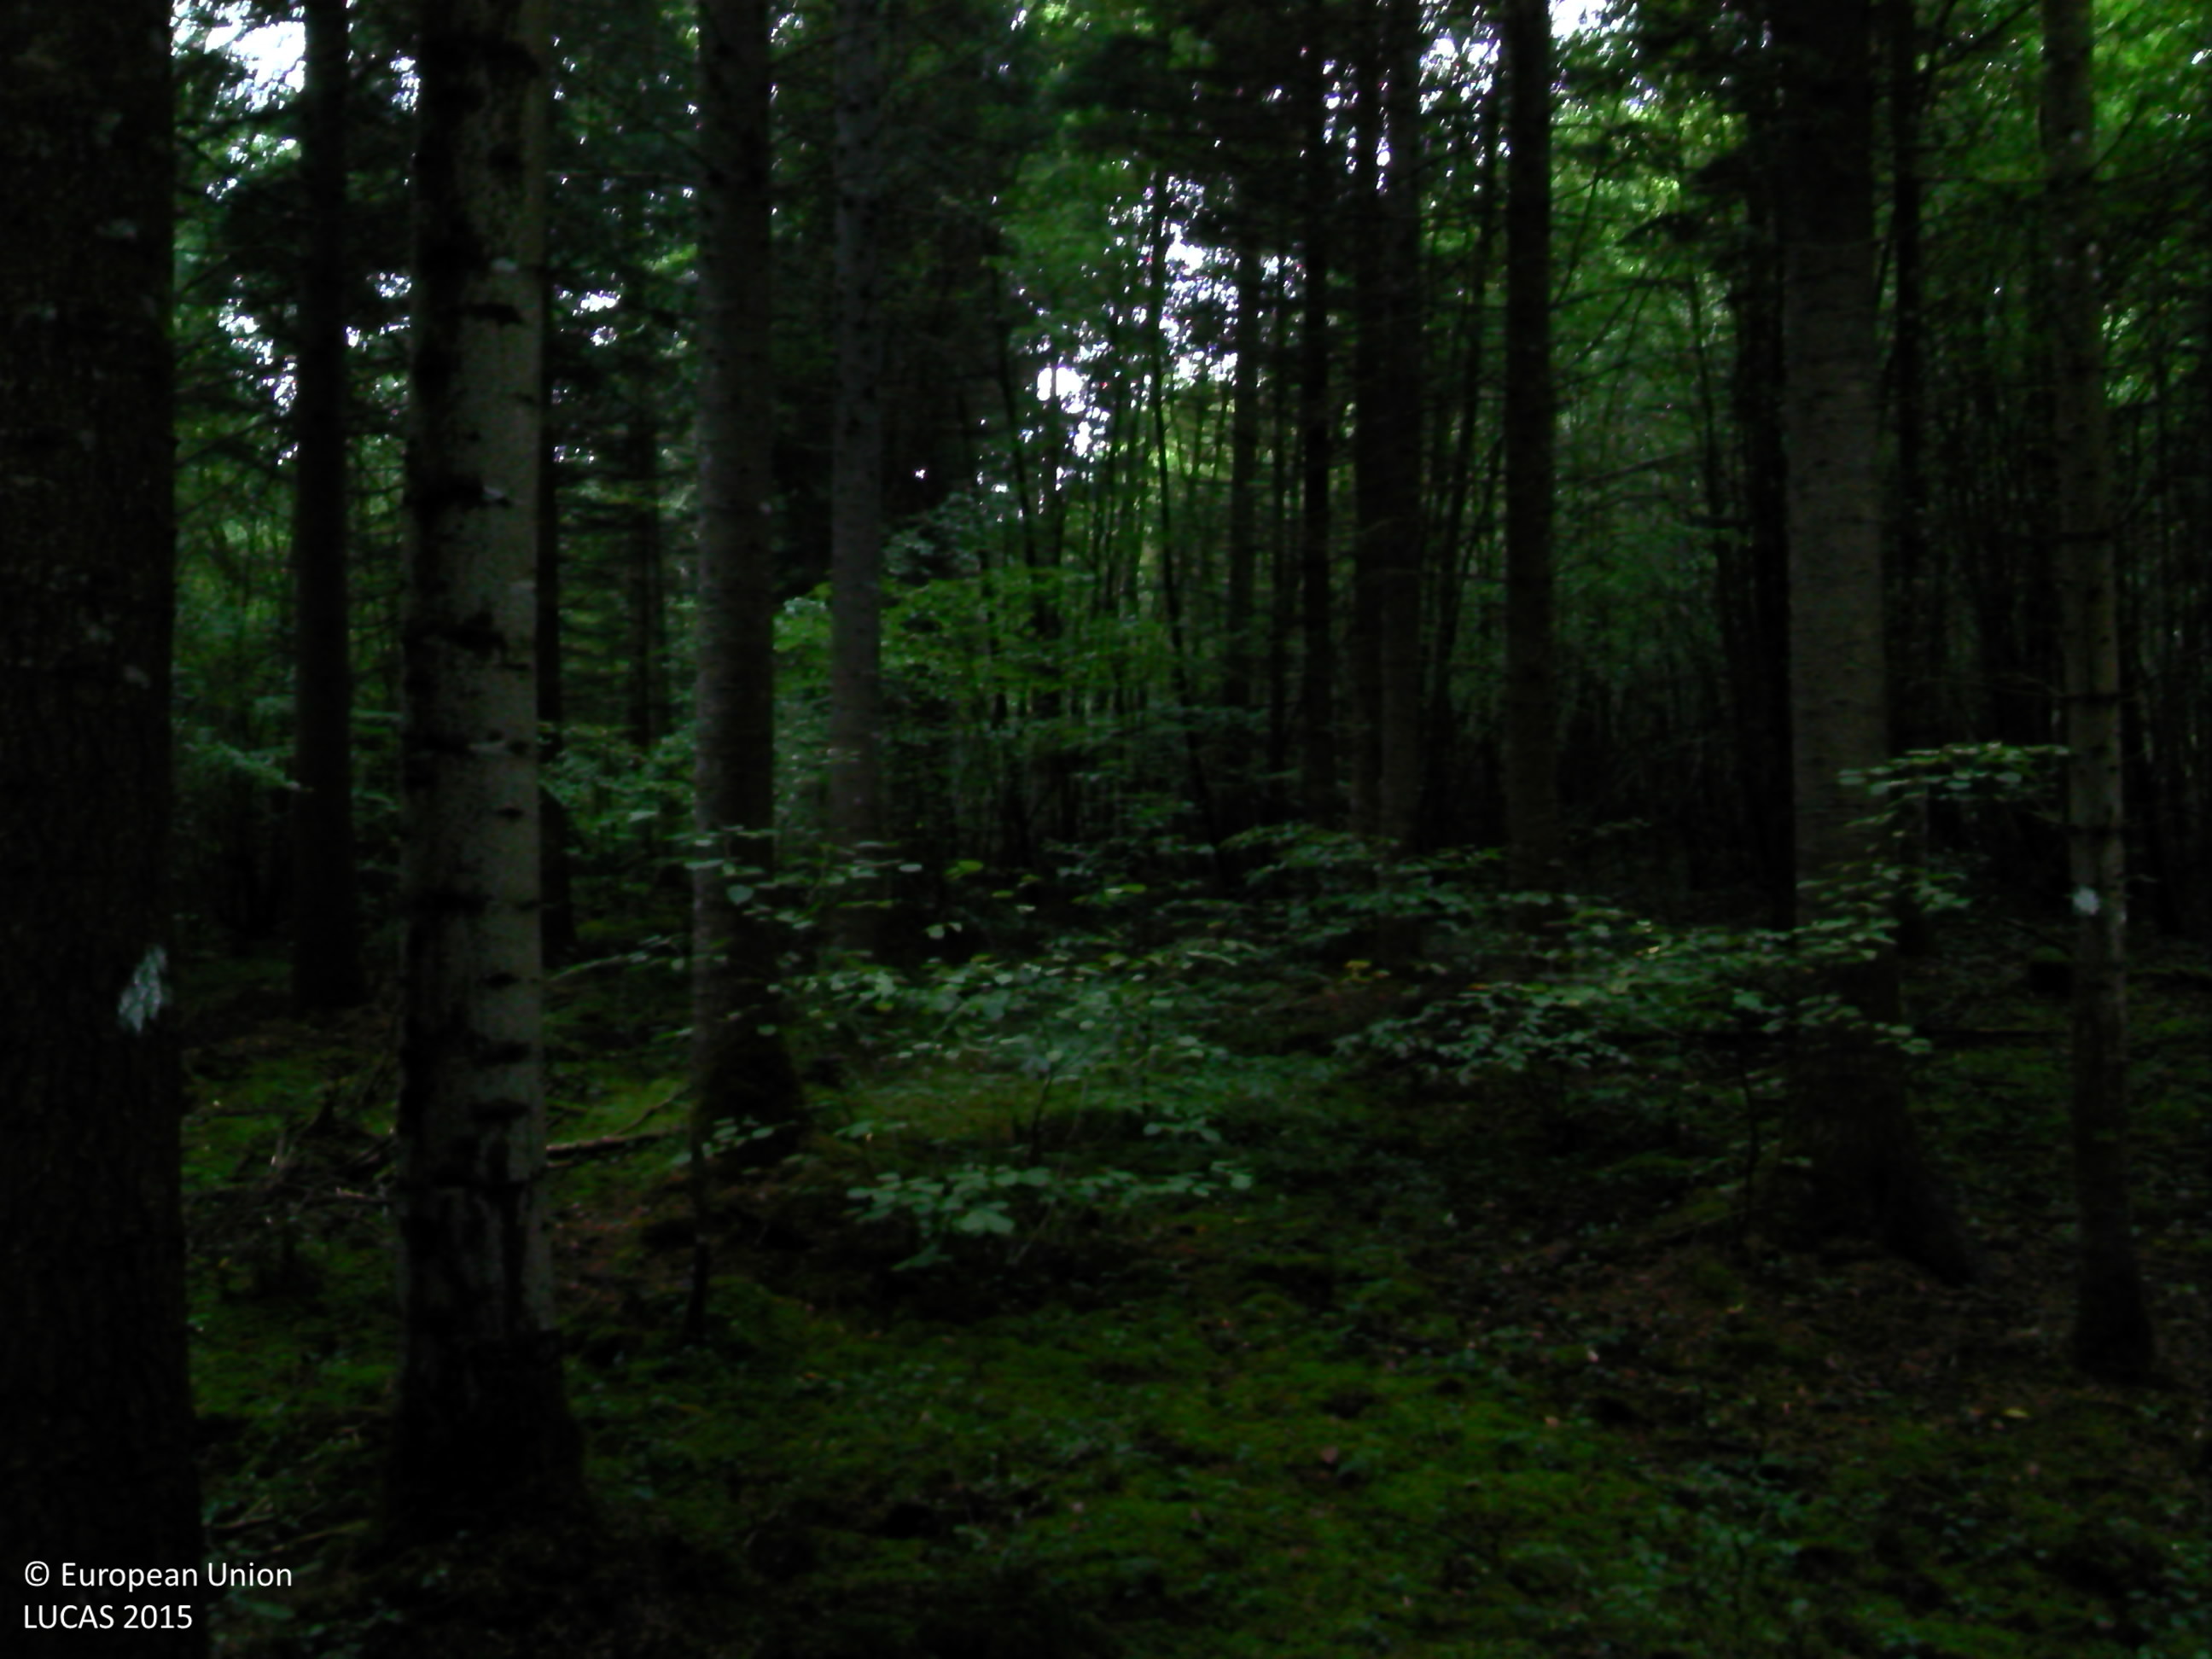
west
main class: Woodland
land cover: Spruce dominated mixed woodland
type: hemiboreal forest and nemoral coniferous forest and mixed broadleaved-coniferous forest
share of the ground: > 75 %
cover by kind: coniferous forest trees 40 %, broadleaved forest trees 40 %, lichens and mosses 15 %, herbaceous plants 5 %
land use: Forestry
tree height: > 5 m
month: September
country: FR
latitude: 48.0228
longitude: 4.6753
